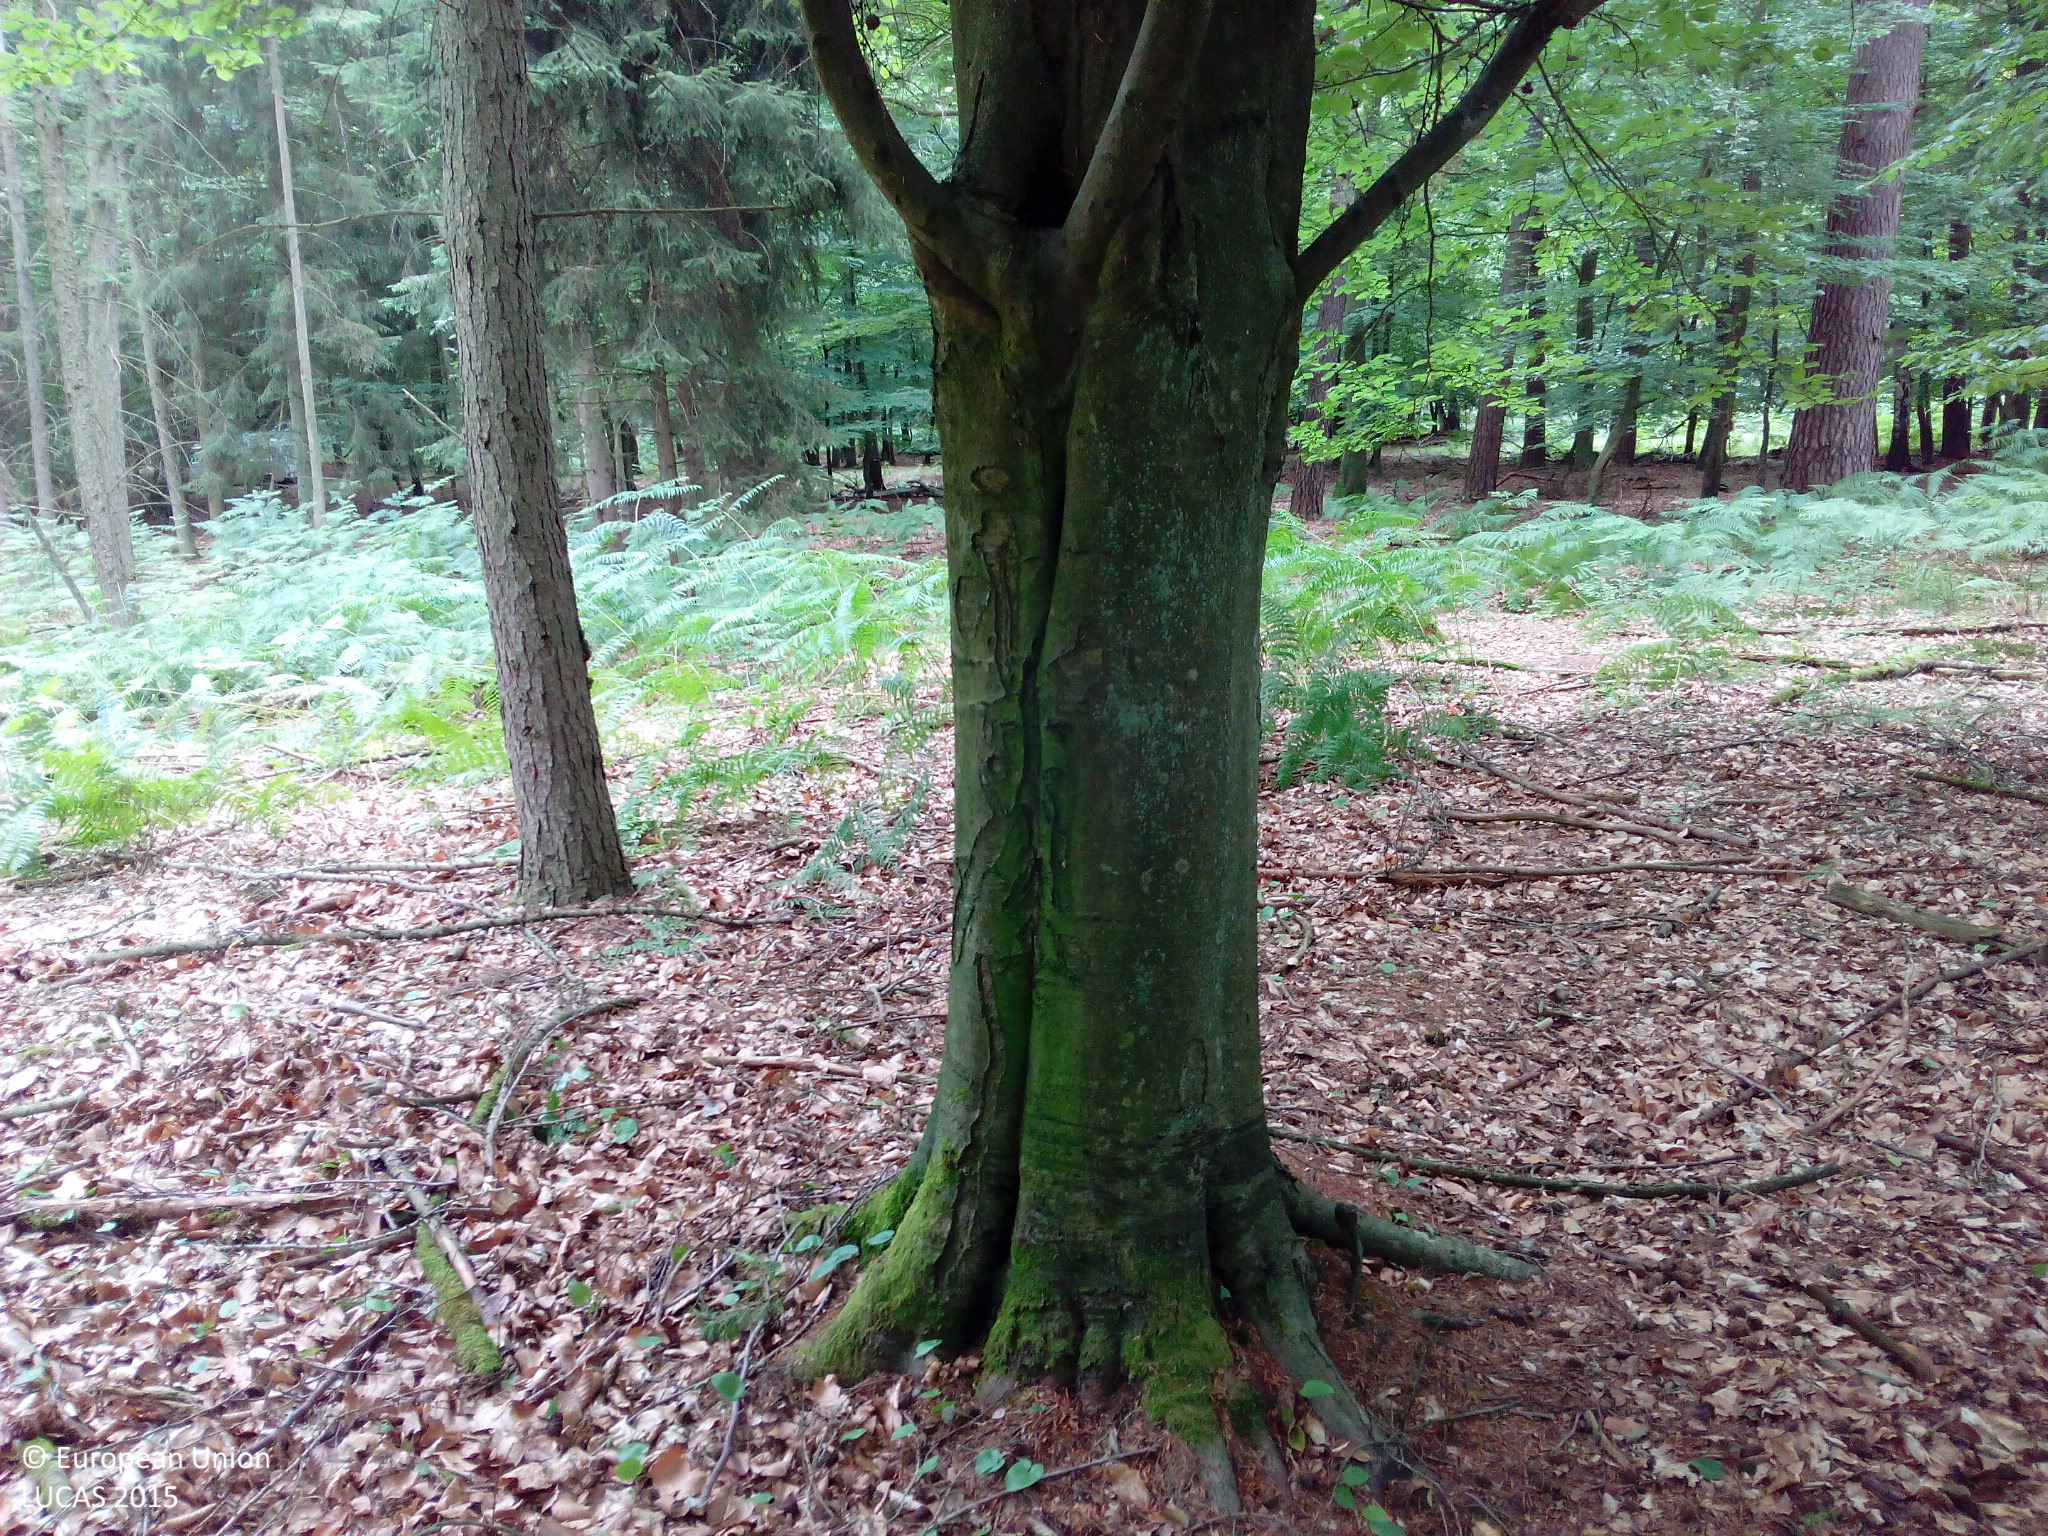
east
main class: Woodland
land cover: Other mixed woodland
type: hemiboreal forest and nemoral coniferous forest and mixed broadleaved-coniferous forest
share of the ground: 50 - 75 %
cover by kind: coniferous forest trees 35 %, broadleaved forest trees 35 %, herbaceous plants 15 %, unconsolidated bare surface 10 %, lichens and mosses 5 %
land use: Forestry
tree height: > 5 m
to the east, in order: Other mixed woodland; Tracks; Broadleaved woodland; Ditches and canals; Broadleaved woodland
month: July
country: DE
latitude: 53.5954
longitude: 14.3069
